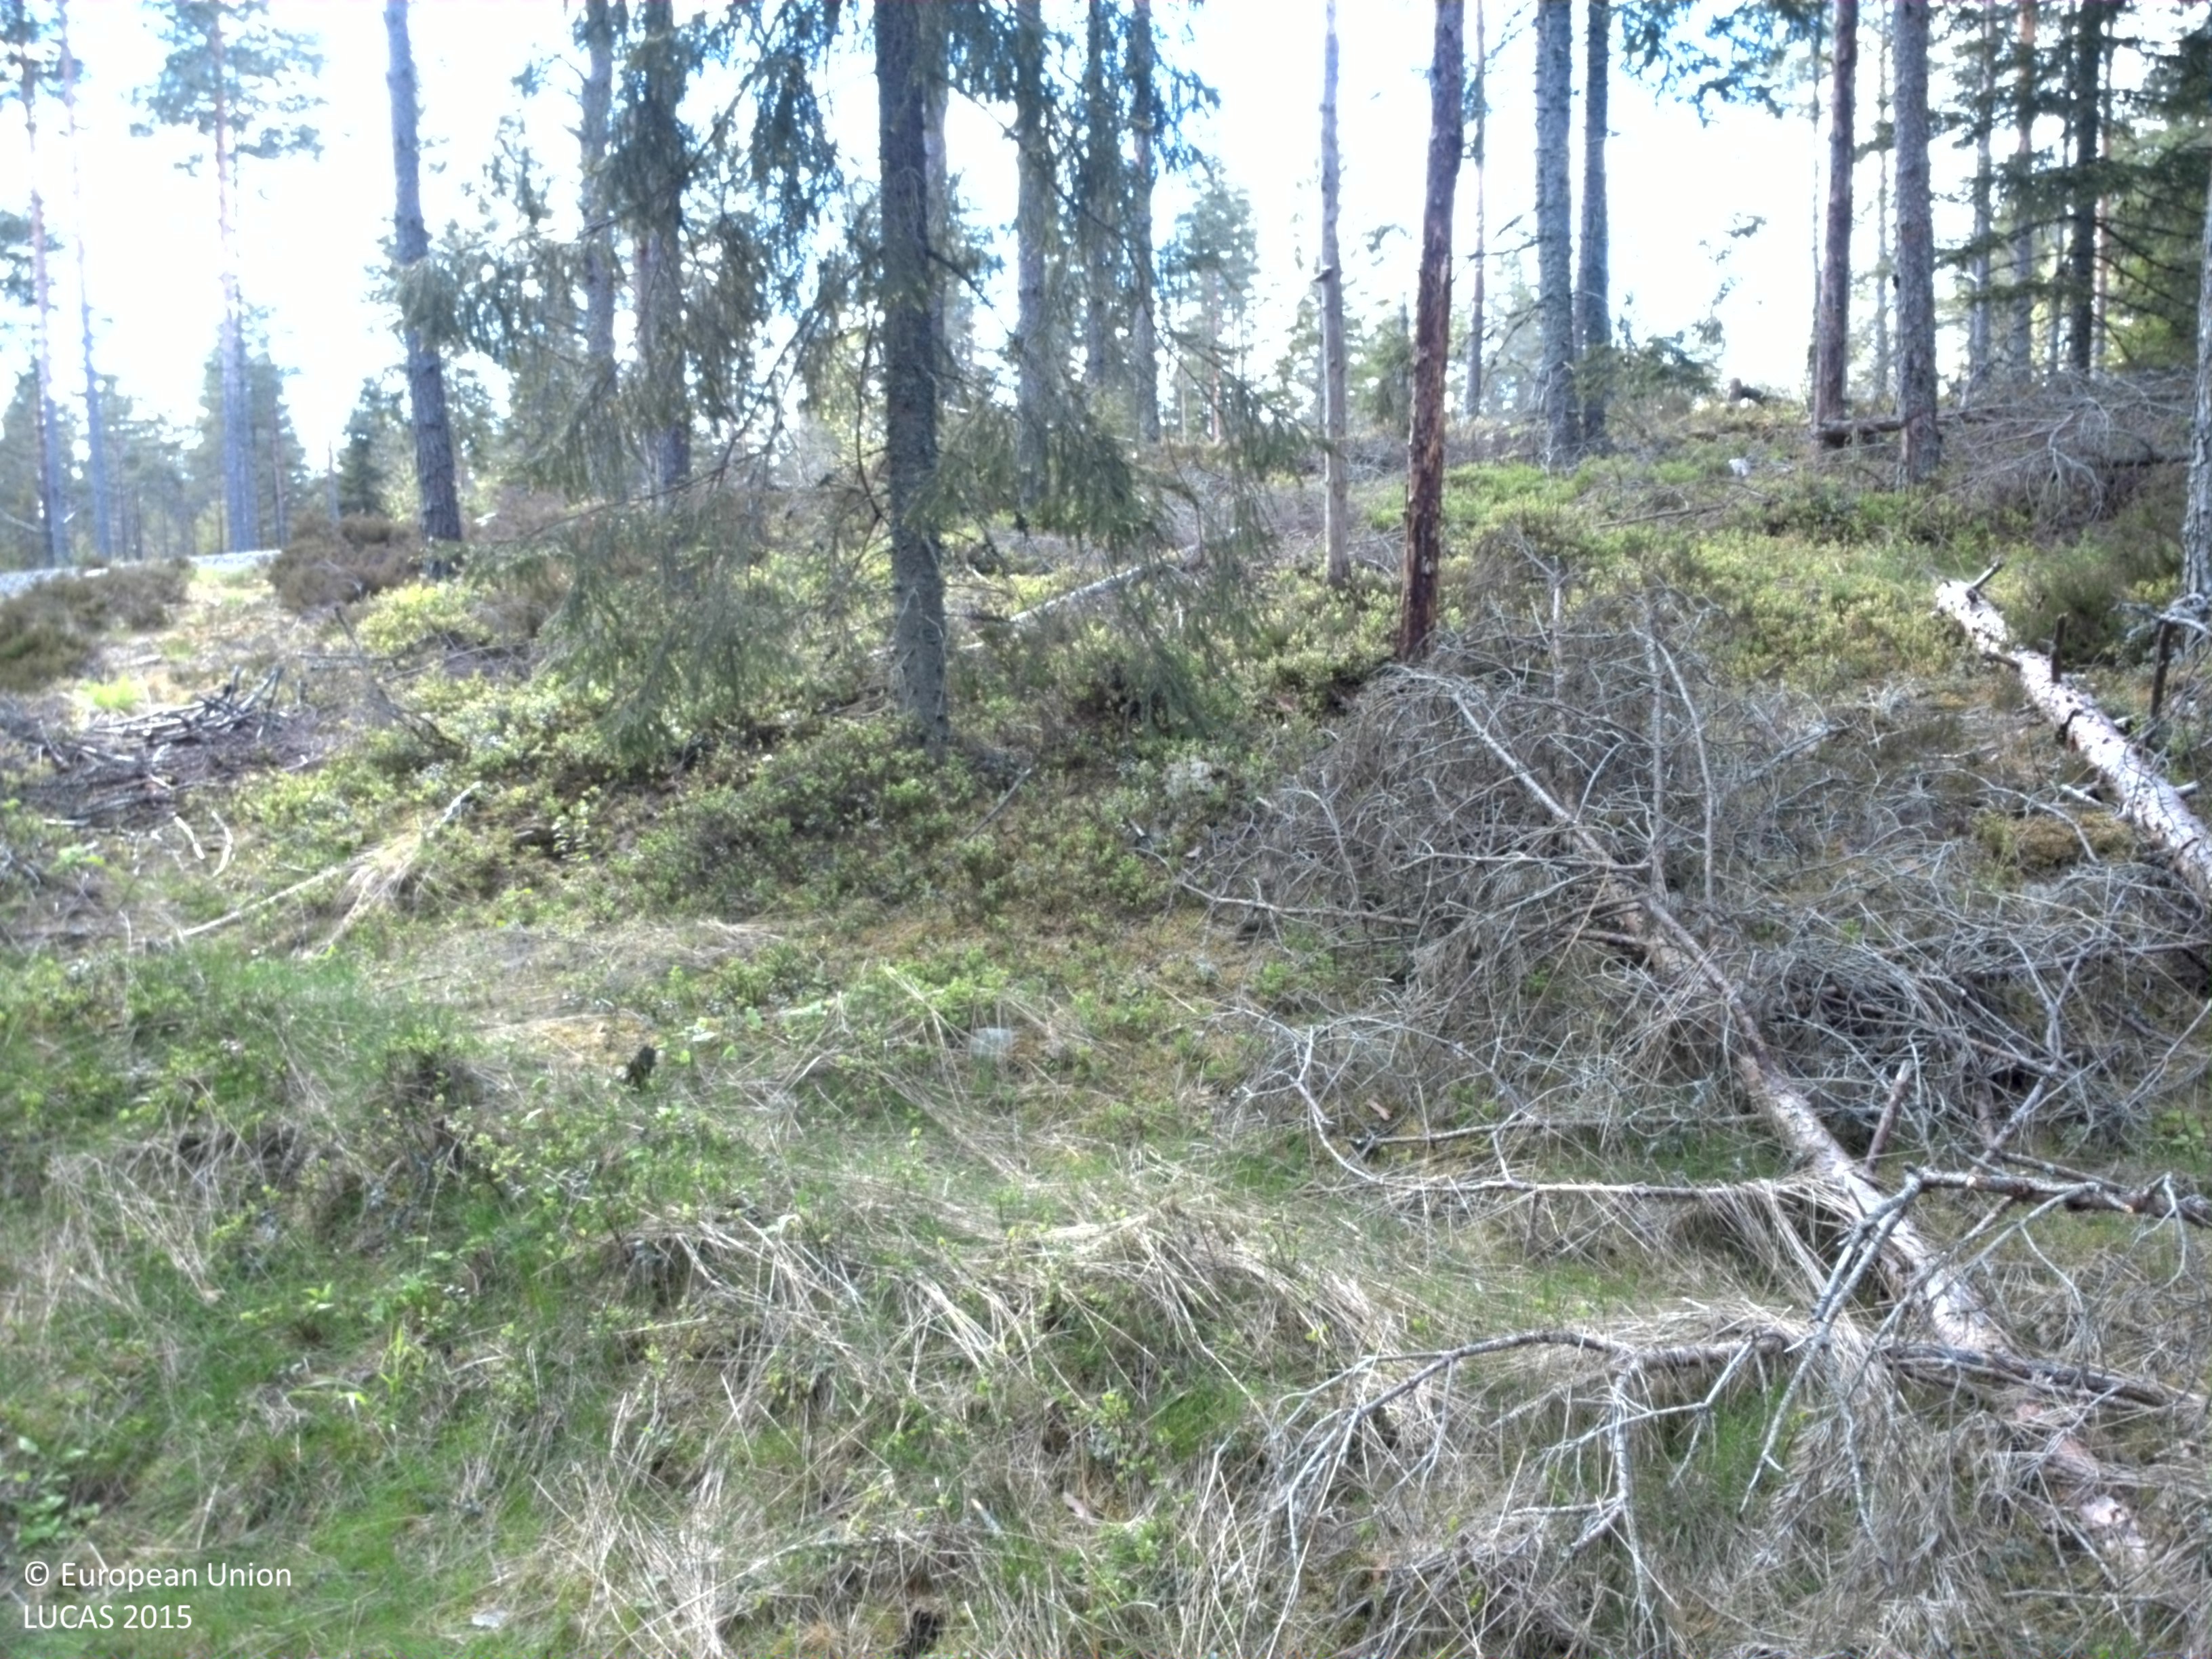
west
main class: Woodland
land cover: Spruce dominated coniferous woodland
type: boreal forest
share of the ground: > 75 %
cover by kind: coniferous forest trees 75 %, shrubs 10 %, broadleaved forest trees 5 %, herbaceous plants 5 %, lichens and mosses 5 %
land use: Forestry
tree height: > 5 m
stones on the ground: 25 - 50 %
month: May
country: SE
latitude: 59.4776
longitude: 12.3065
